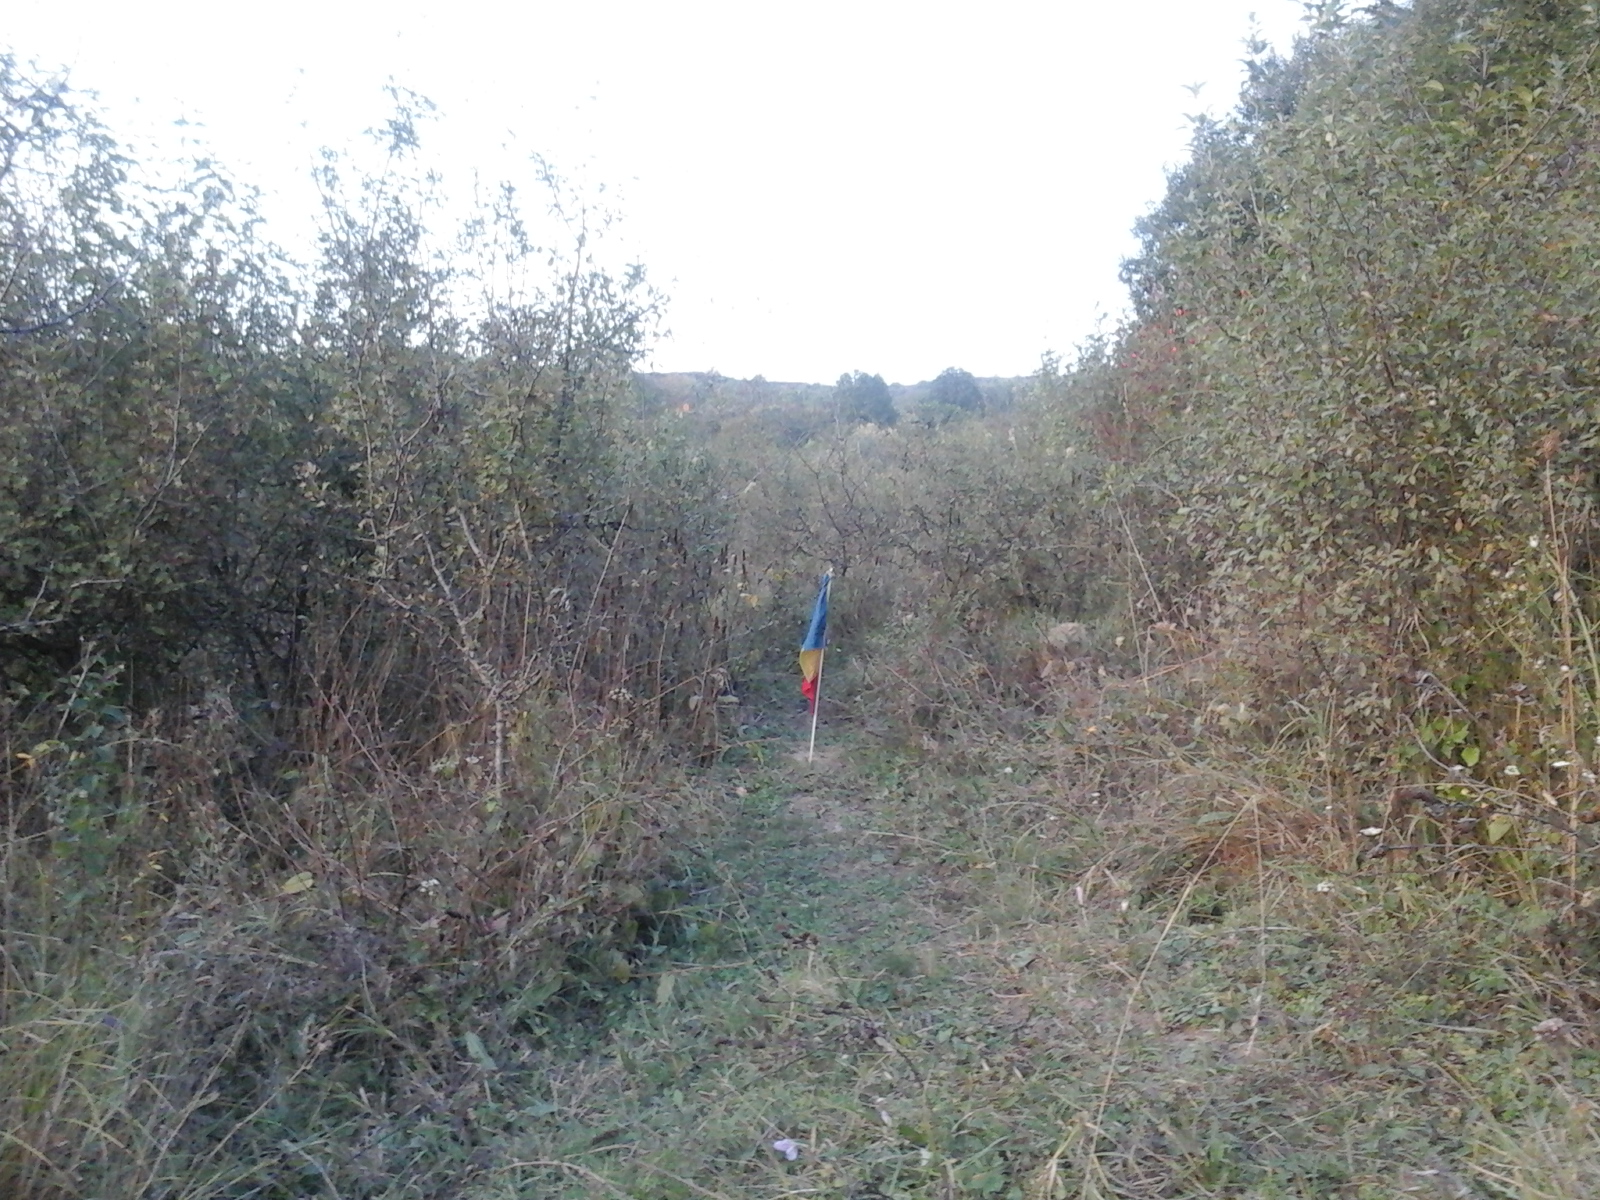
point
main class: Shrubland
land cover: Shrubland without tree cover
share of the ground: > 75 %
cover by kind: shrubs 100 %
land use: Semi-natural and natural areas not in use
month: September
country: RO
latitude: 46.9639
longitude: 24.1048
